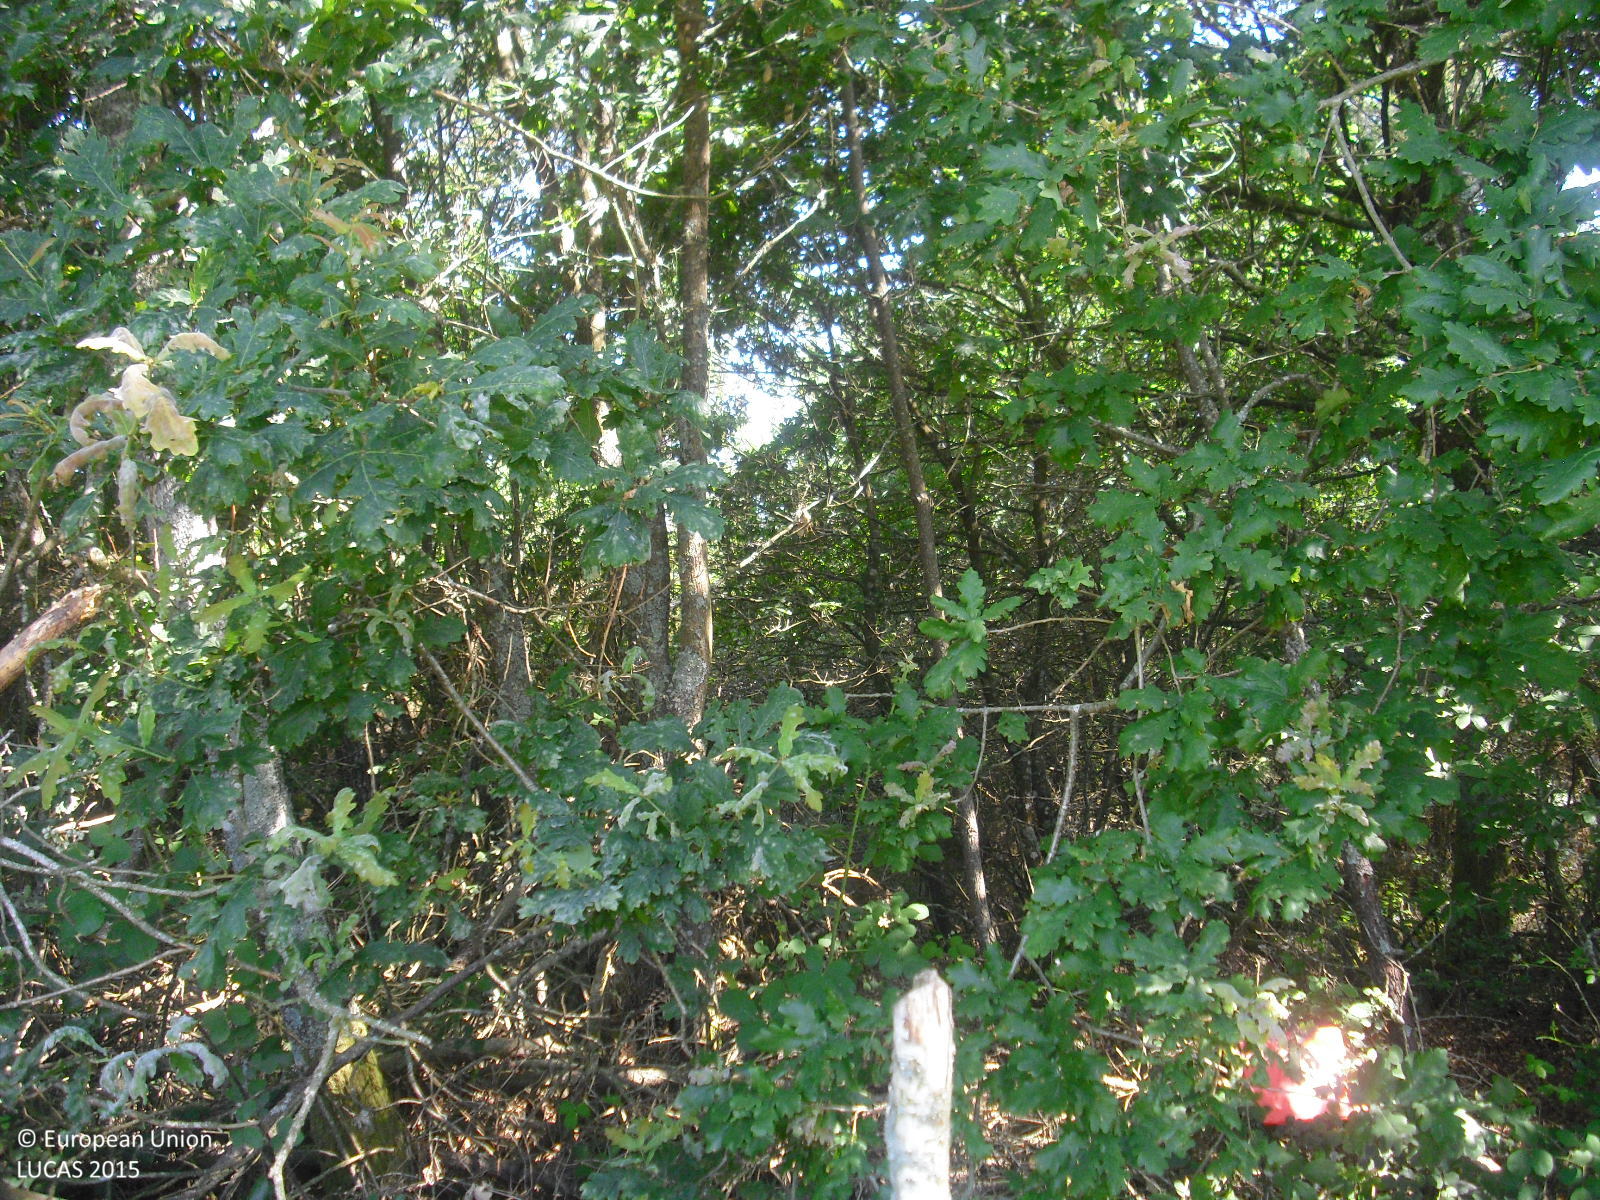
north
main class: Woodland
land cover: Broadleaved woodland
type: acidophilous oak and oak-birch forest
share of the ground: > 75 %
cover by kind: broadleaved forest trees 80 %, coniferous forest trees 20 %
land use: Forestry
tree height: > 5 m
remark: Clear cut
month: June
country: ES
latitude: 42.5784
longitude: -7.7810
